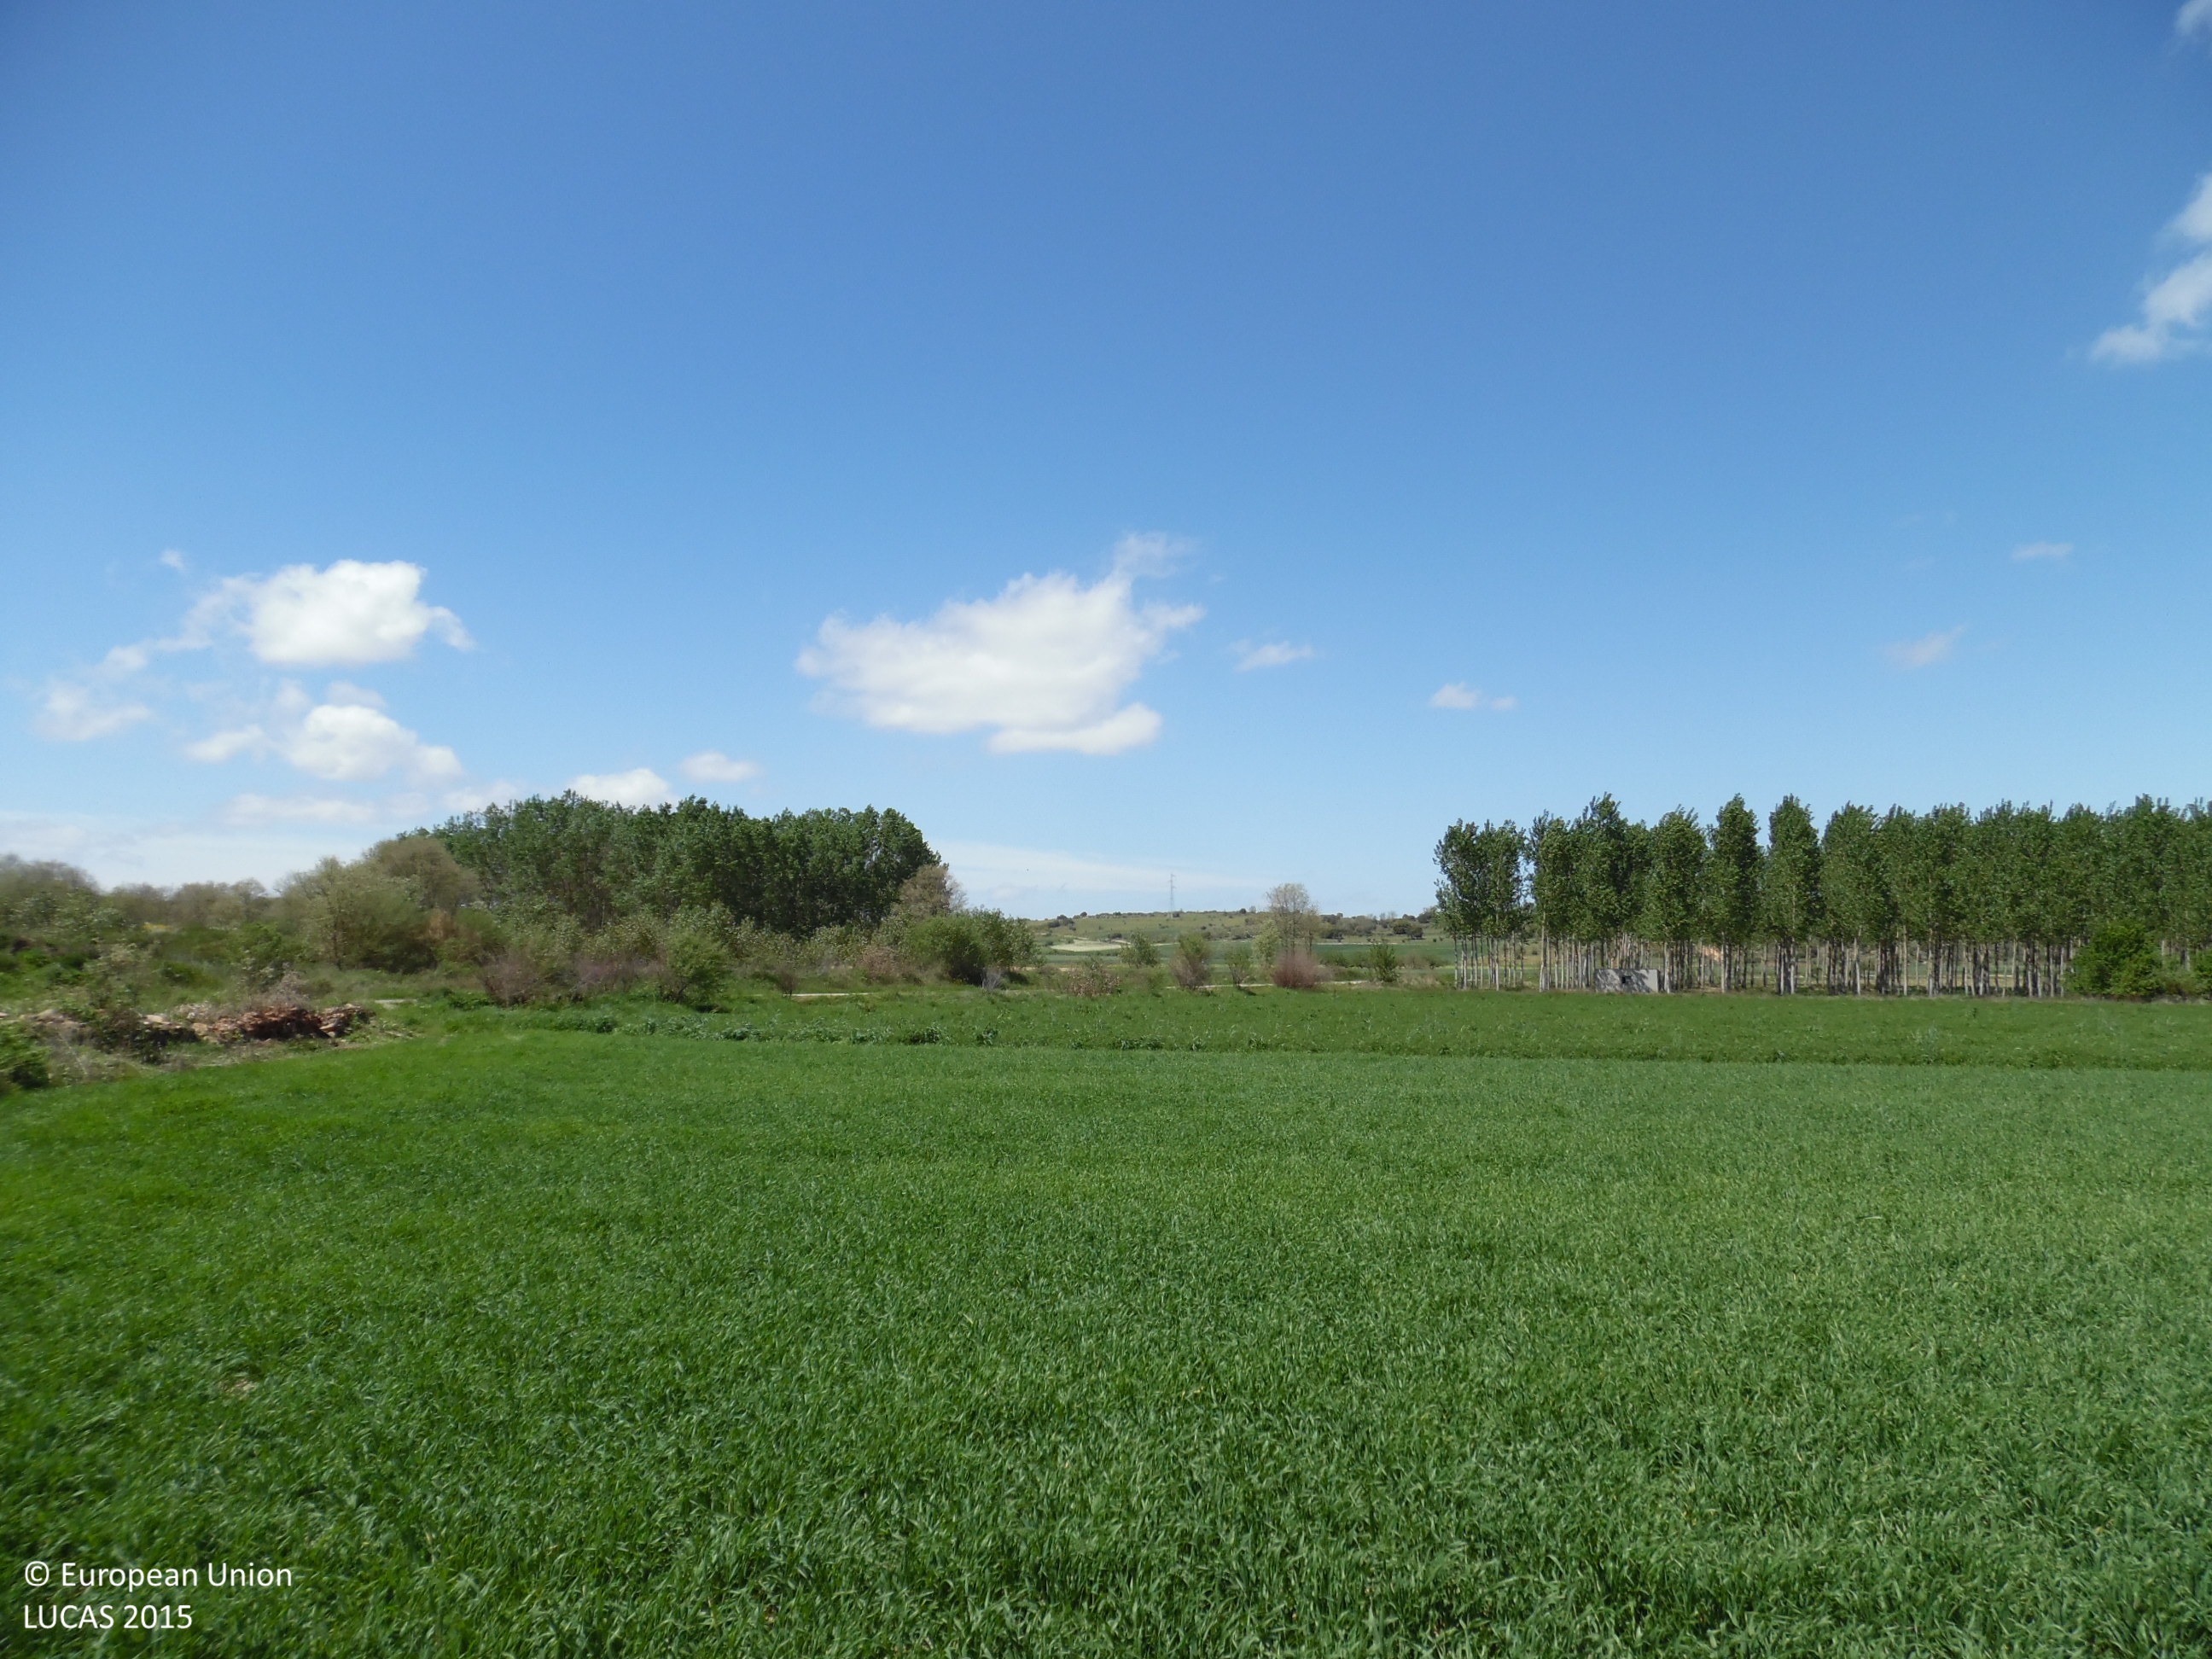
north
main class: Cropland
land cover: Durum wheat
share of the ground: > 75 %
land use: Agriculture (excluding fallow land and kitchen gardens)
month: May
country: ES
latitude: 42.5196
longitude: -6.0648
